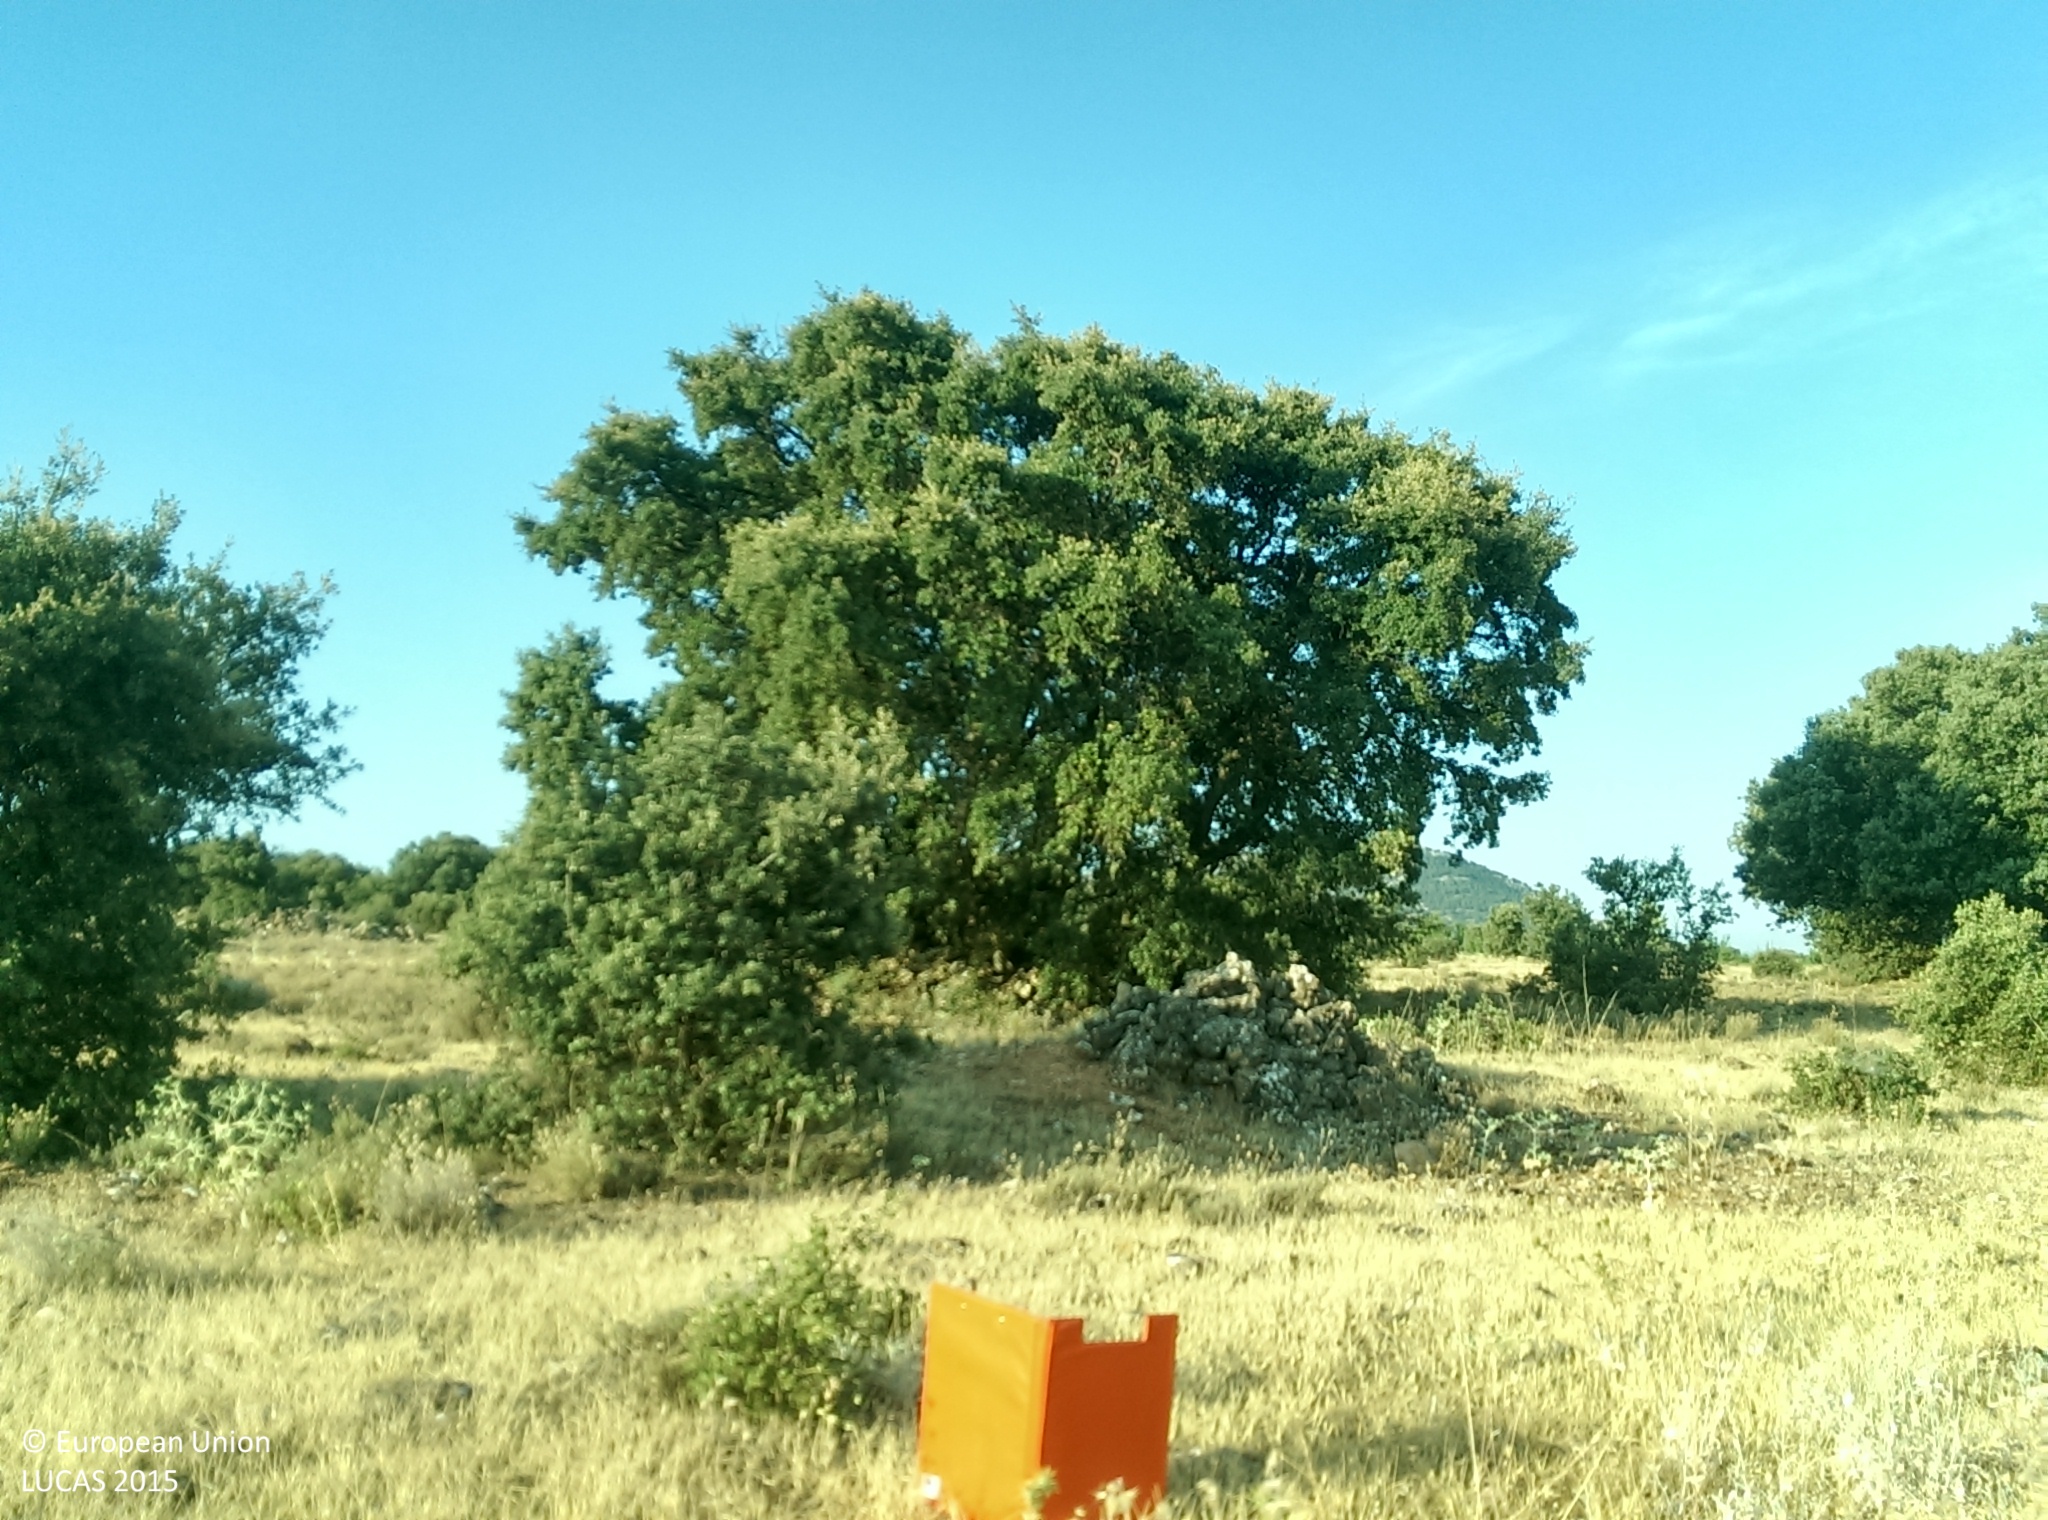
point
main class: Grassland
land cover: Grassland with sparse tree/shrub cover
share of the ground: > 75 %
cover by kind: herbaceous plants 90 %, broadleaved forest trees 5 %, shrubs 5 %
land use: Semi-natural and natural areas not in use
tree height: > 5 m
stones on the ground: > 50 %
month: July
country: ES
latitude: 37.3910
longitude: -2.9424
